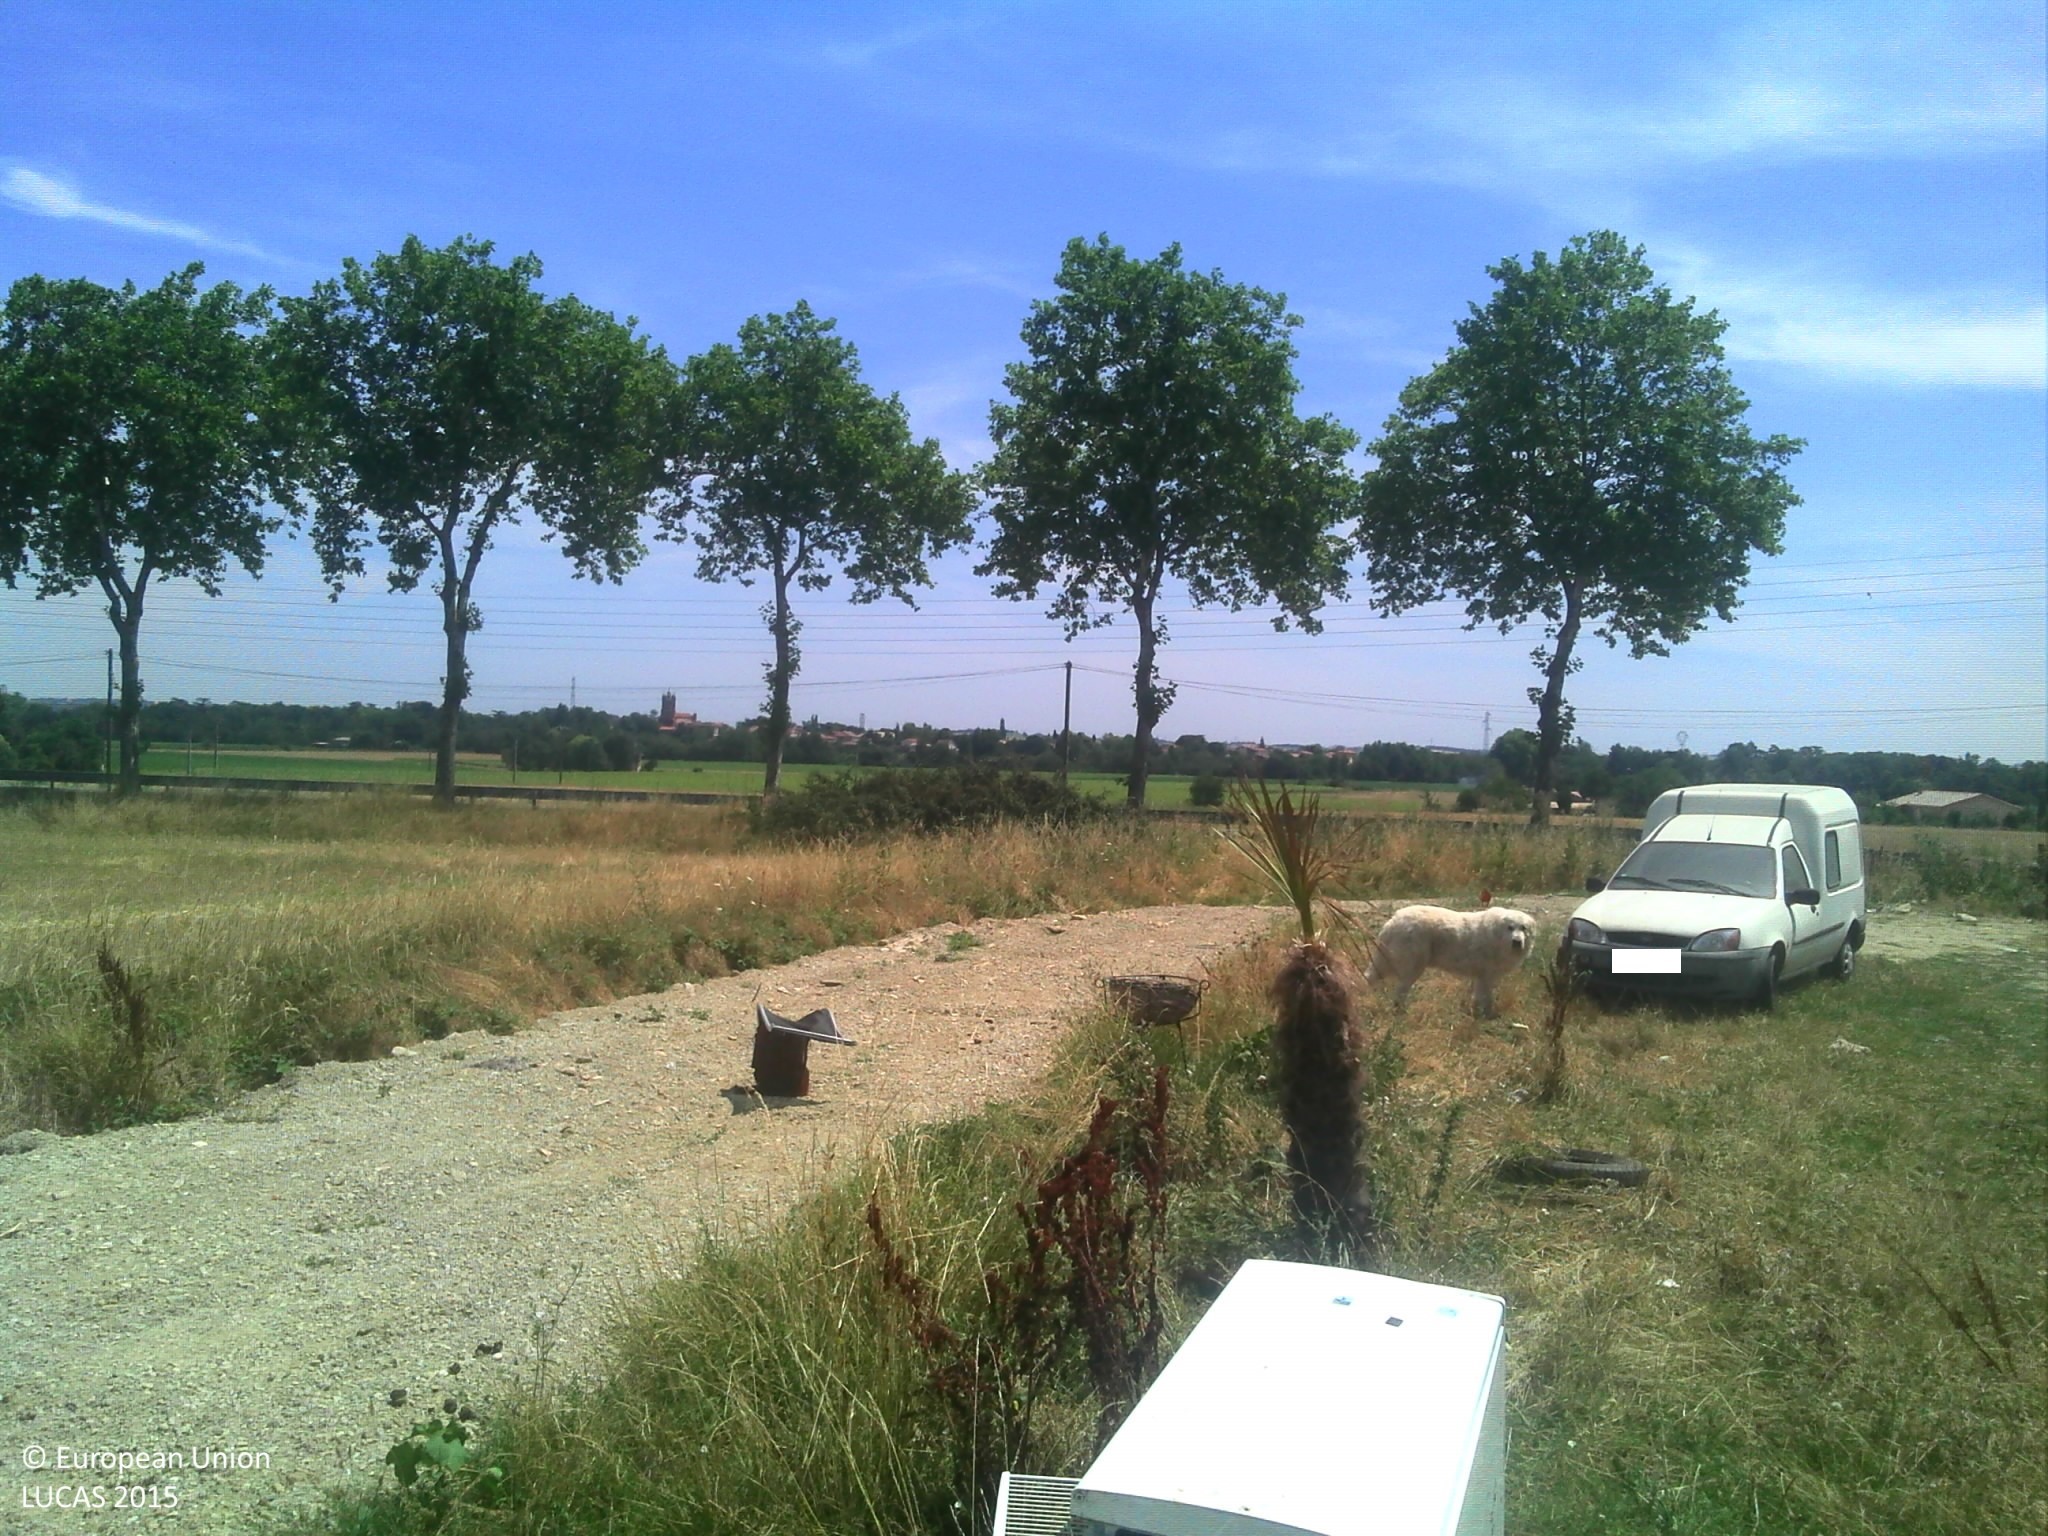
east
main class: Grassland
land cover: Spontaneously vegetated surfaces
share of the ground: > 75 %
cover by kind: herbaceous plants 80 %, consolidated bare surface 20 %
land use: Residential
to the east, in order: Spontaneously vegetated surfaces; Fences; Ditches and canals; Electric lines; Lines of trees; Fences; Paved roads, cycling and walking lanes; Grass margins; Electric lines; Common wheat; Ditches and canals; Grassland without tree/shrub cover; Ditches and canals; Common wheat
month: July
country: FR
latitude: 43.4103
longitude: 1.3712
